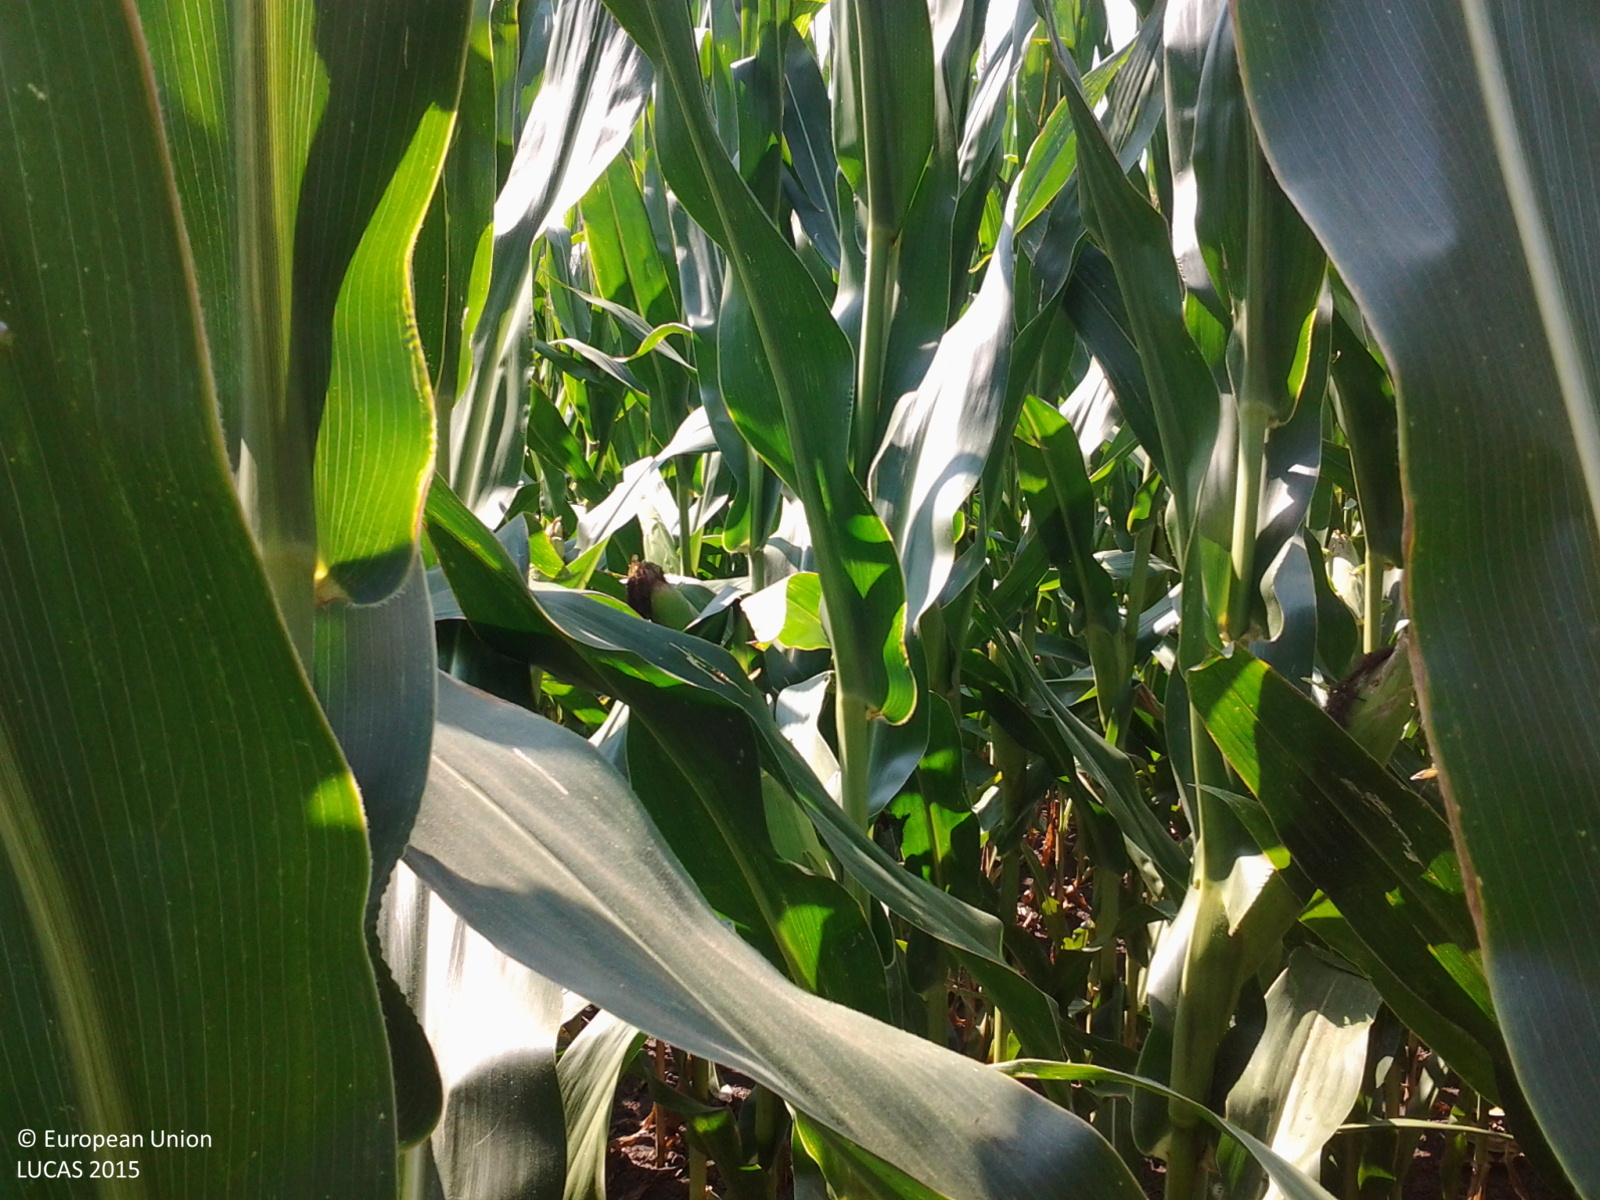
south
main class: Cropland
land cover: Maize
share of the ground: > 75 %
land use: Agriculture (excluding fallow land and kitchen gardens)
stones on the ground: < 10 %
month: August
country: HU
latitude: 47.2742
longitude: 19.8452
